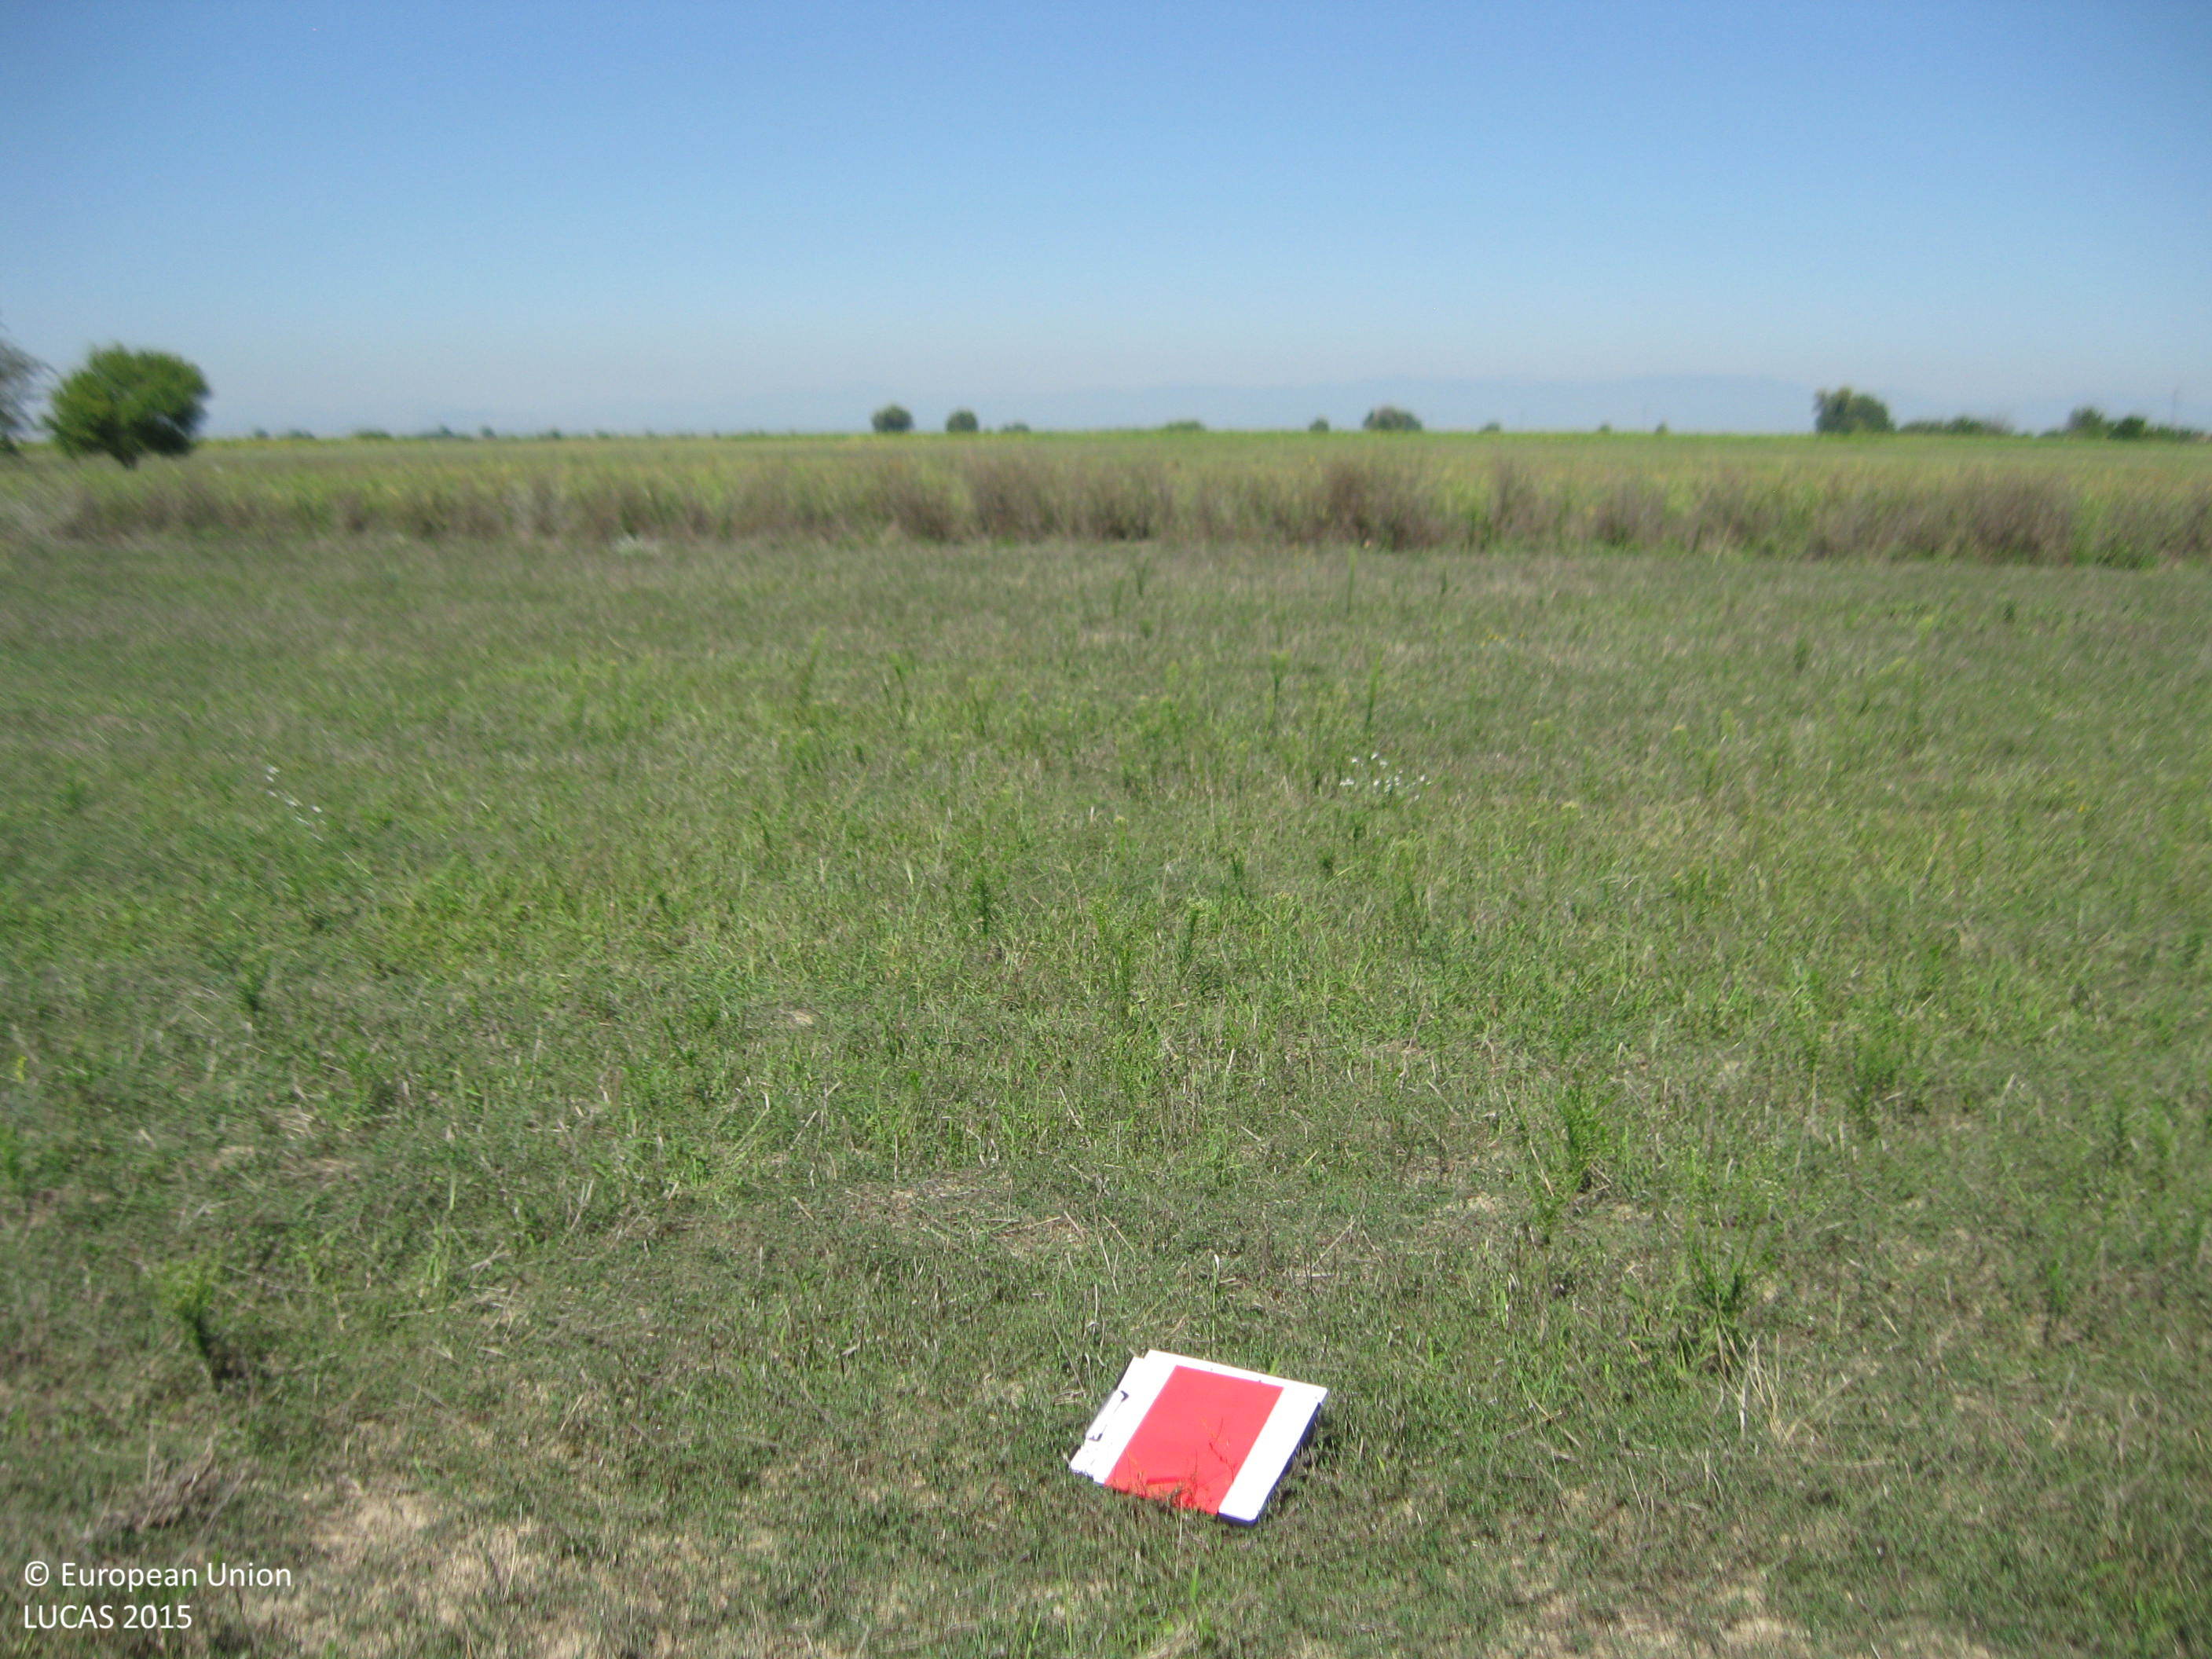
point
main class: Cropland
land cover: Common wheat
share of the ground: < 10 %
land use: Agriculture (excluding fallow land and kitchen gardens)
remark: Harvested field
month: September
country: BG
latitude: 42.2236
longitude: 24.6495
